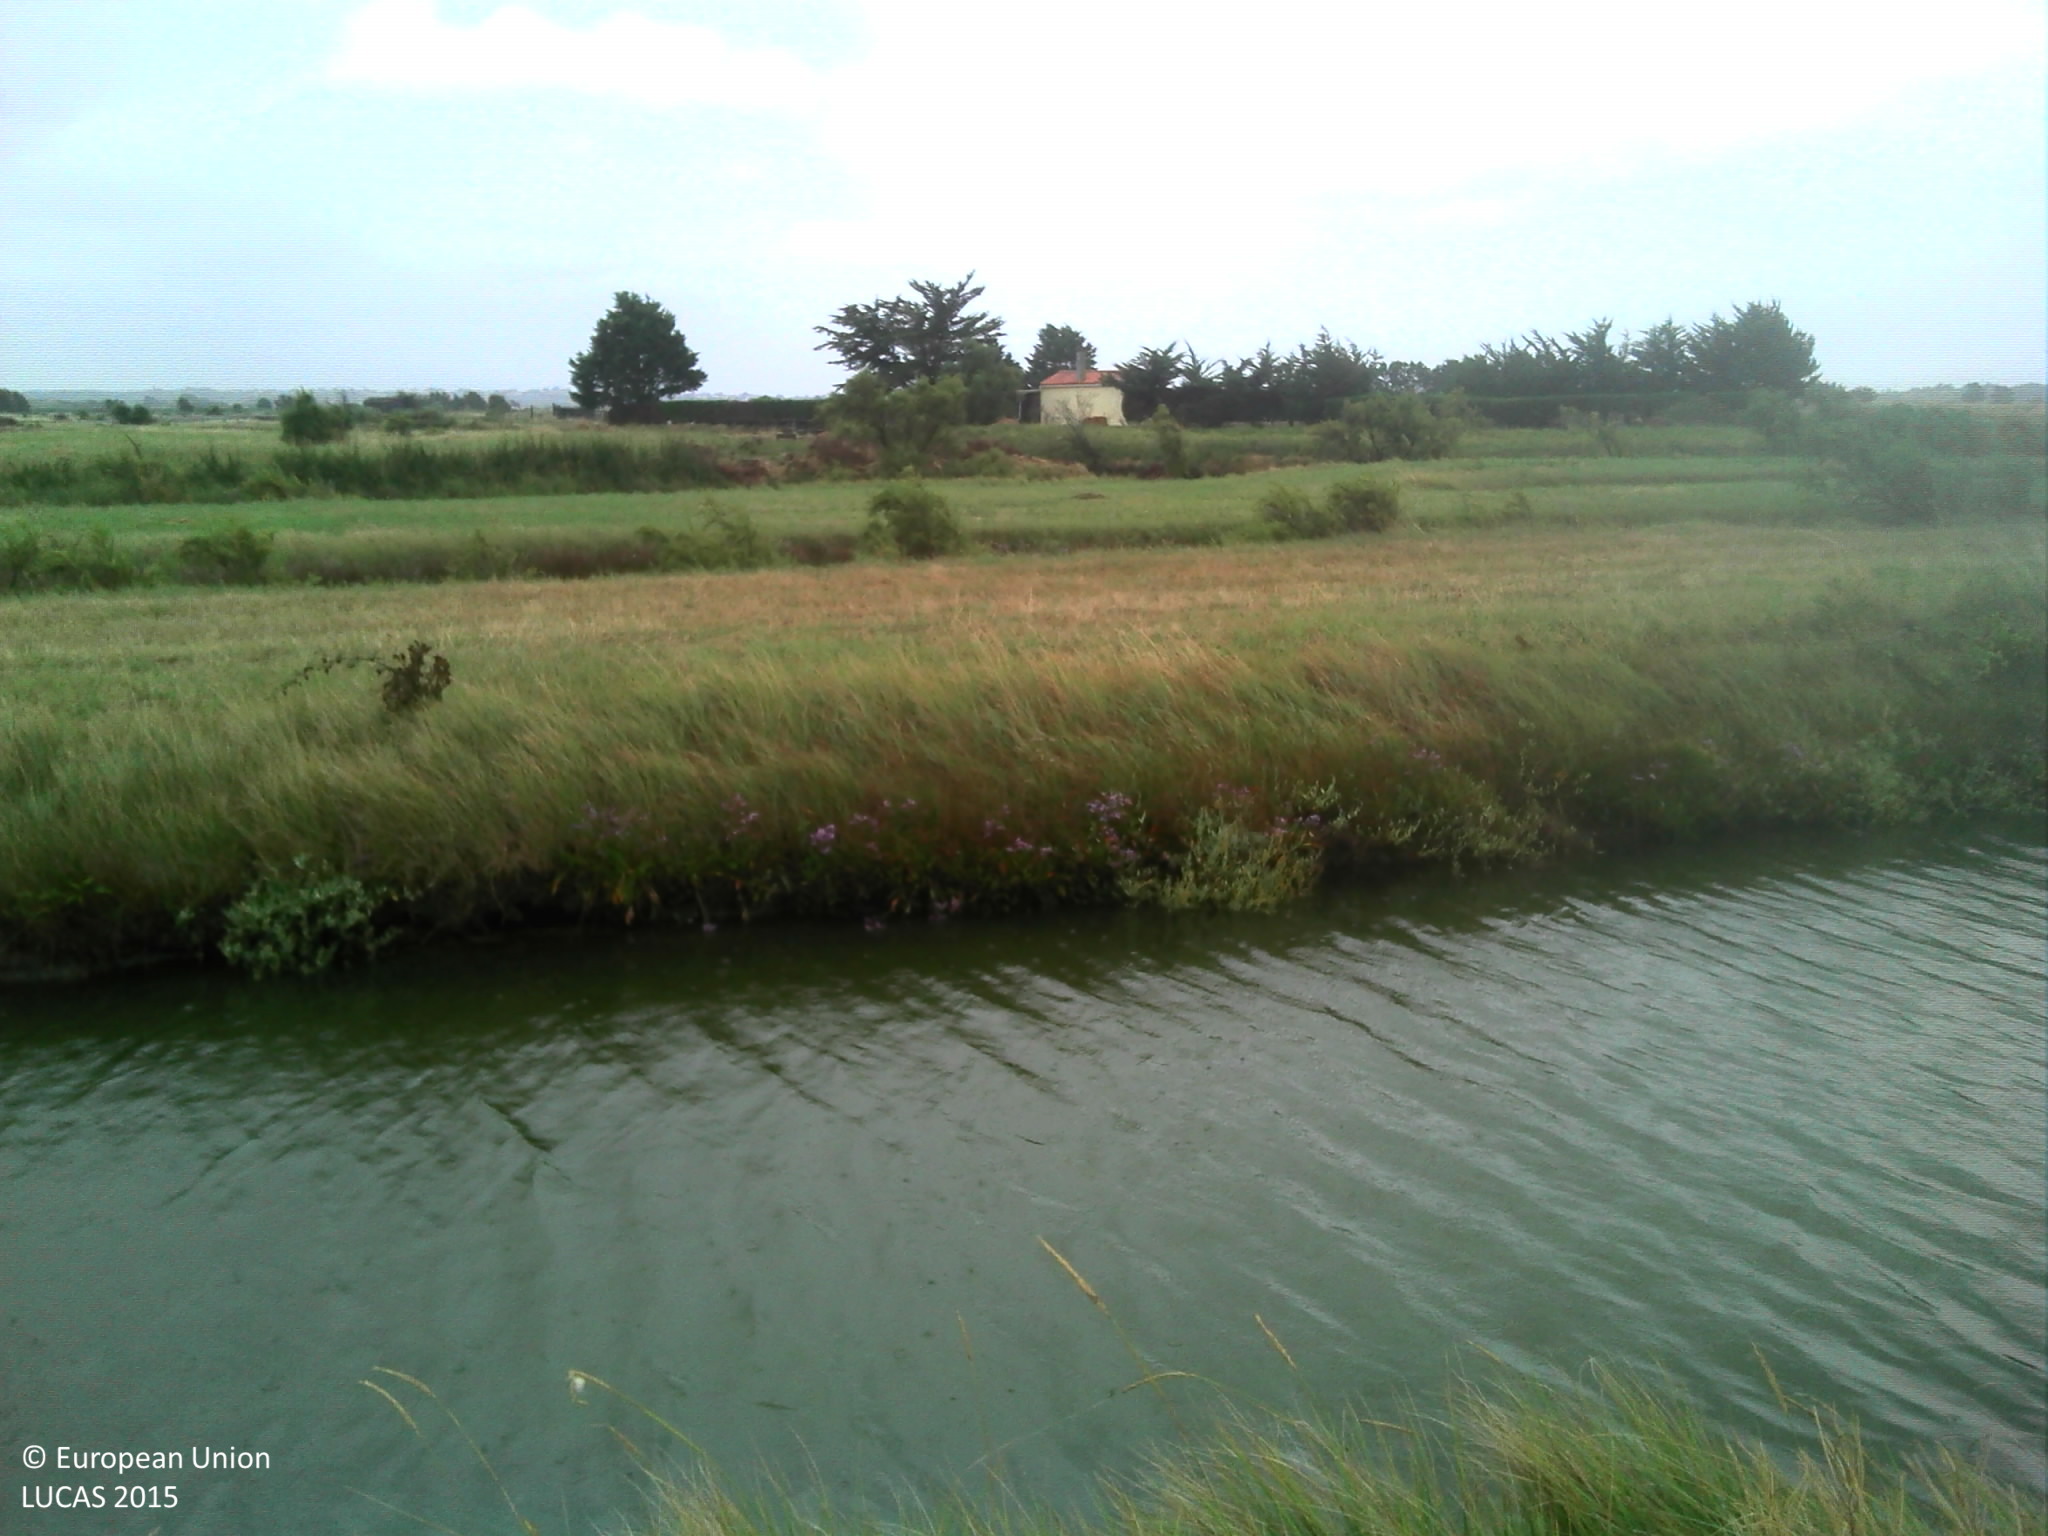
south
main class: Grassland
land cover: Spontaneously vegetated surfaces
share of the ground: > 75 %
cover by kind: herbaceous plants 95 %, shrubs 5 %
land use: Semi-natural and natural areas not in use
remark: Temporary flooded
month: August
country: FR
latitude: 46.5691
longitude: -1.7971
